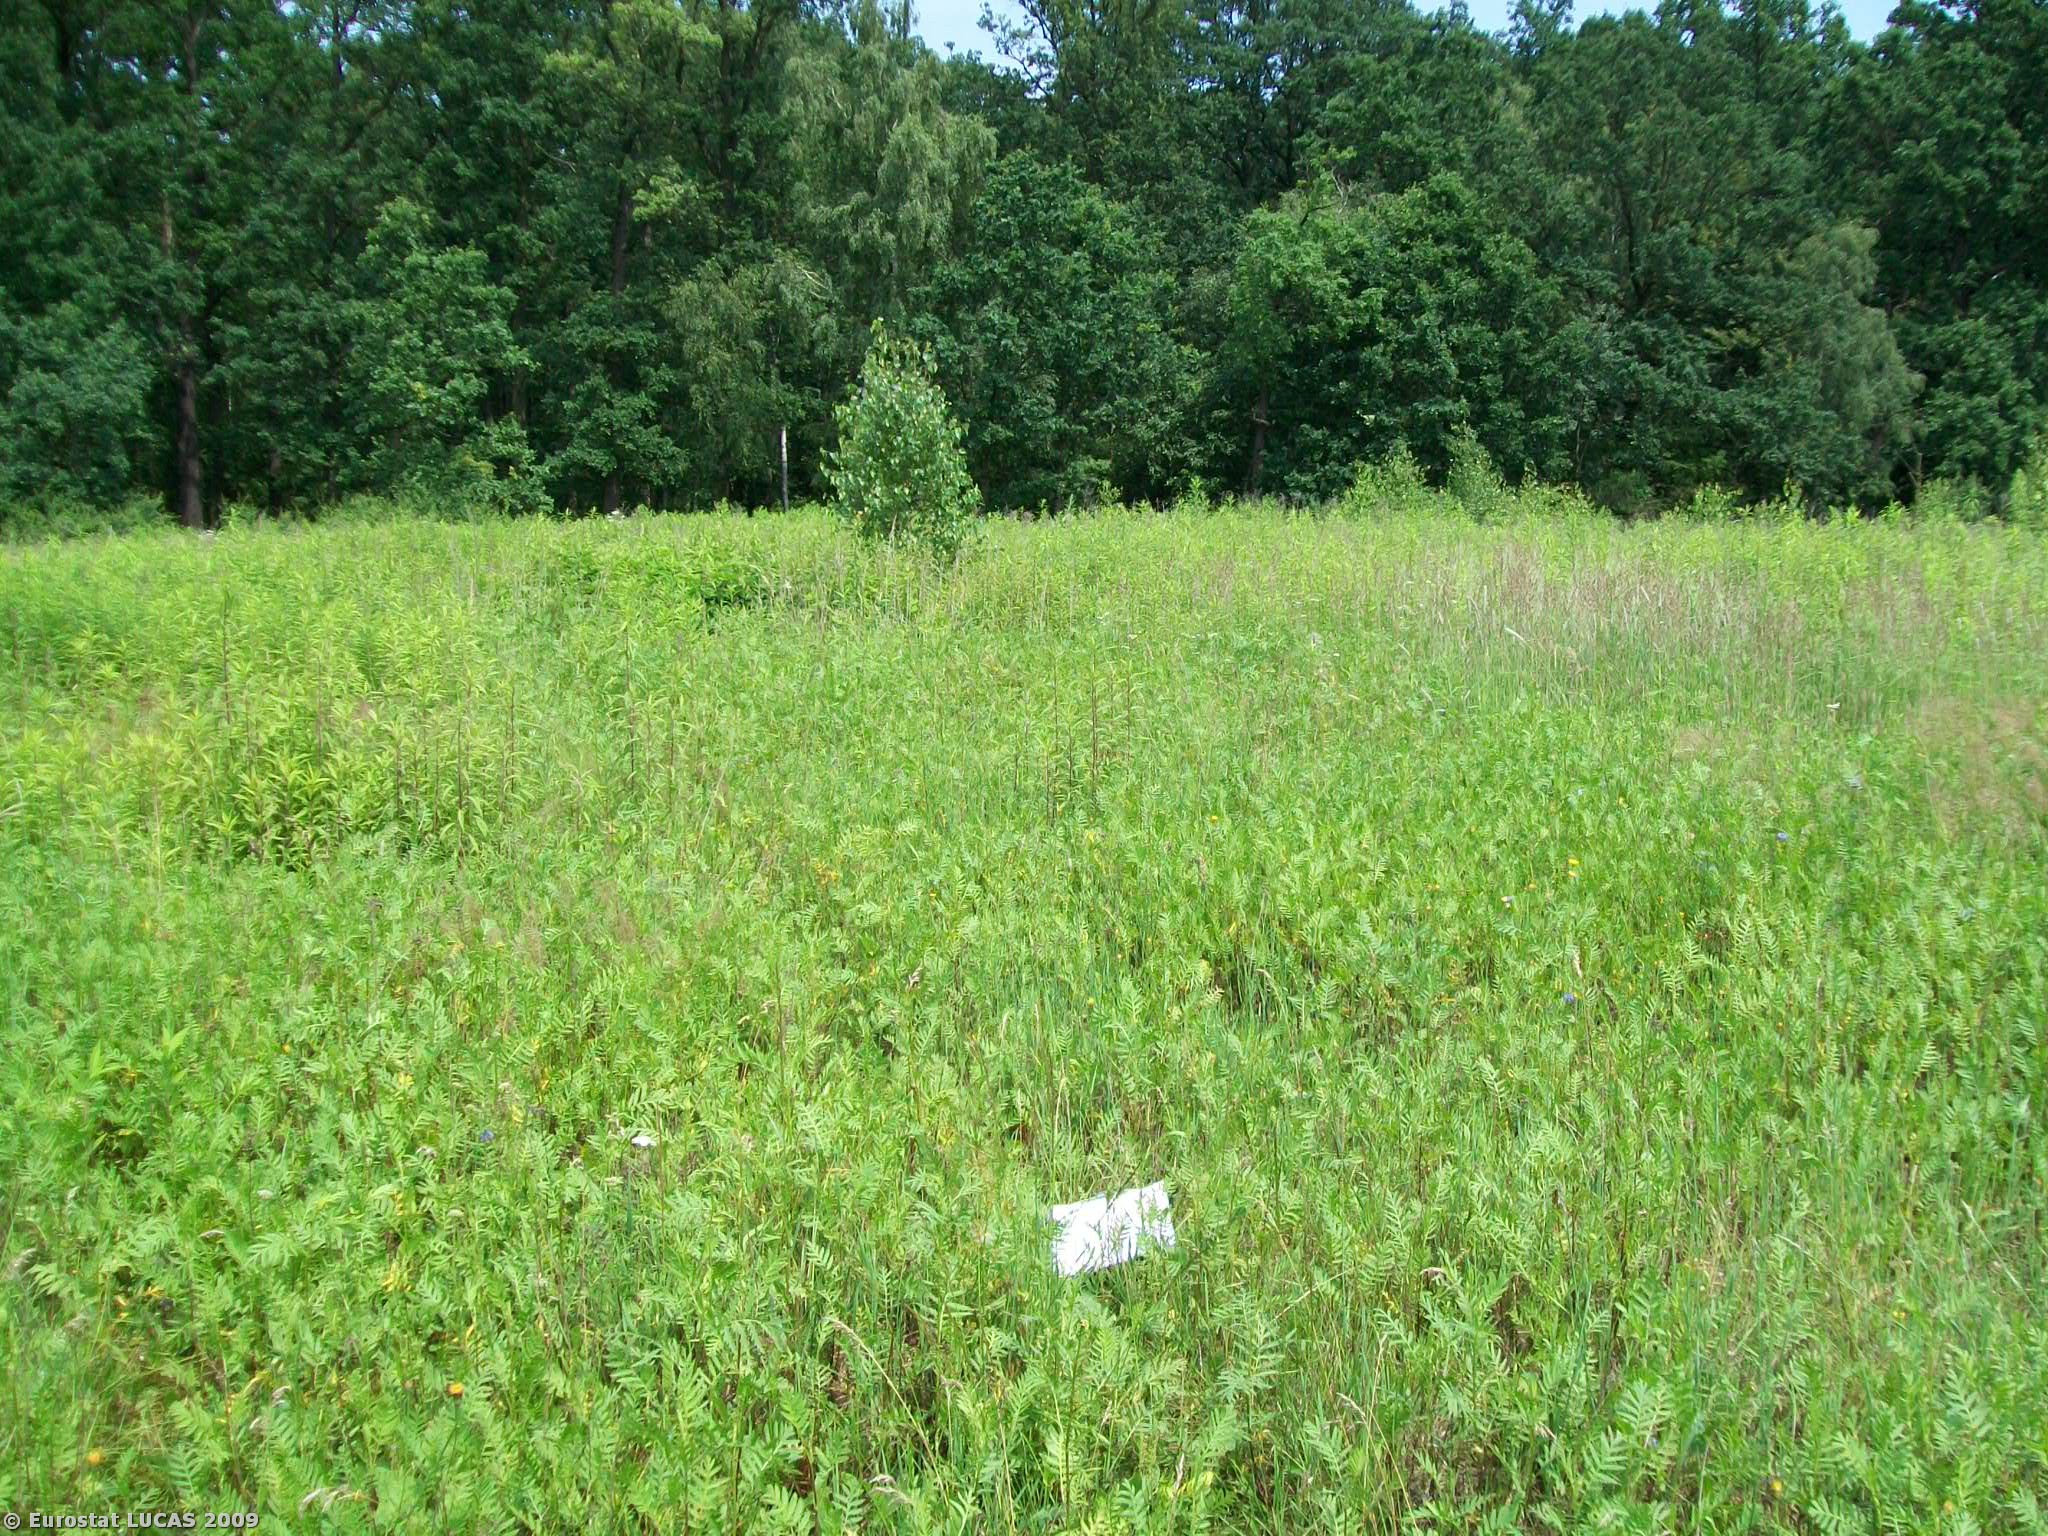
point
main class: Grassland
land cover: Spontaneously vegetated surfaces
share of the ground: > 75 %
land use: Unused
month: July
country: PL
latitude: 51.2094
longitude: 16.7798
